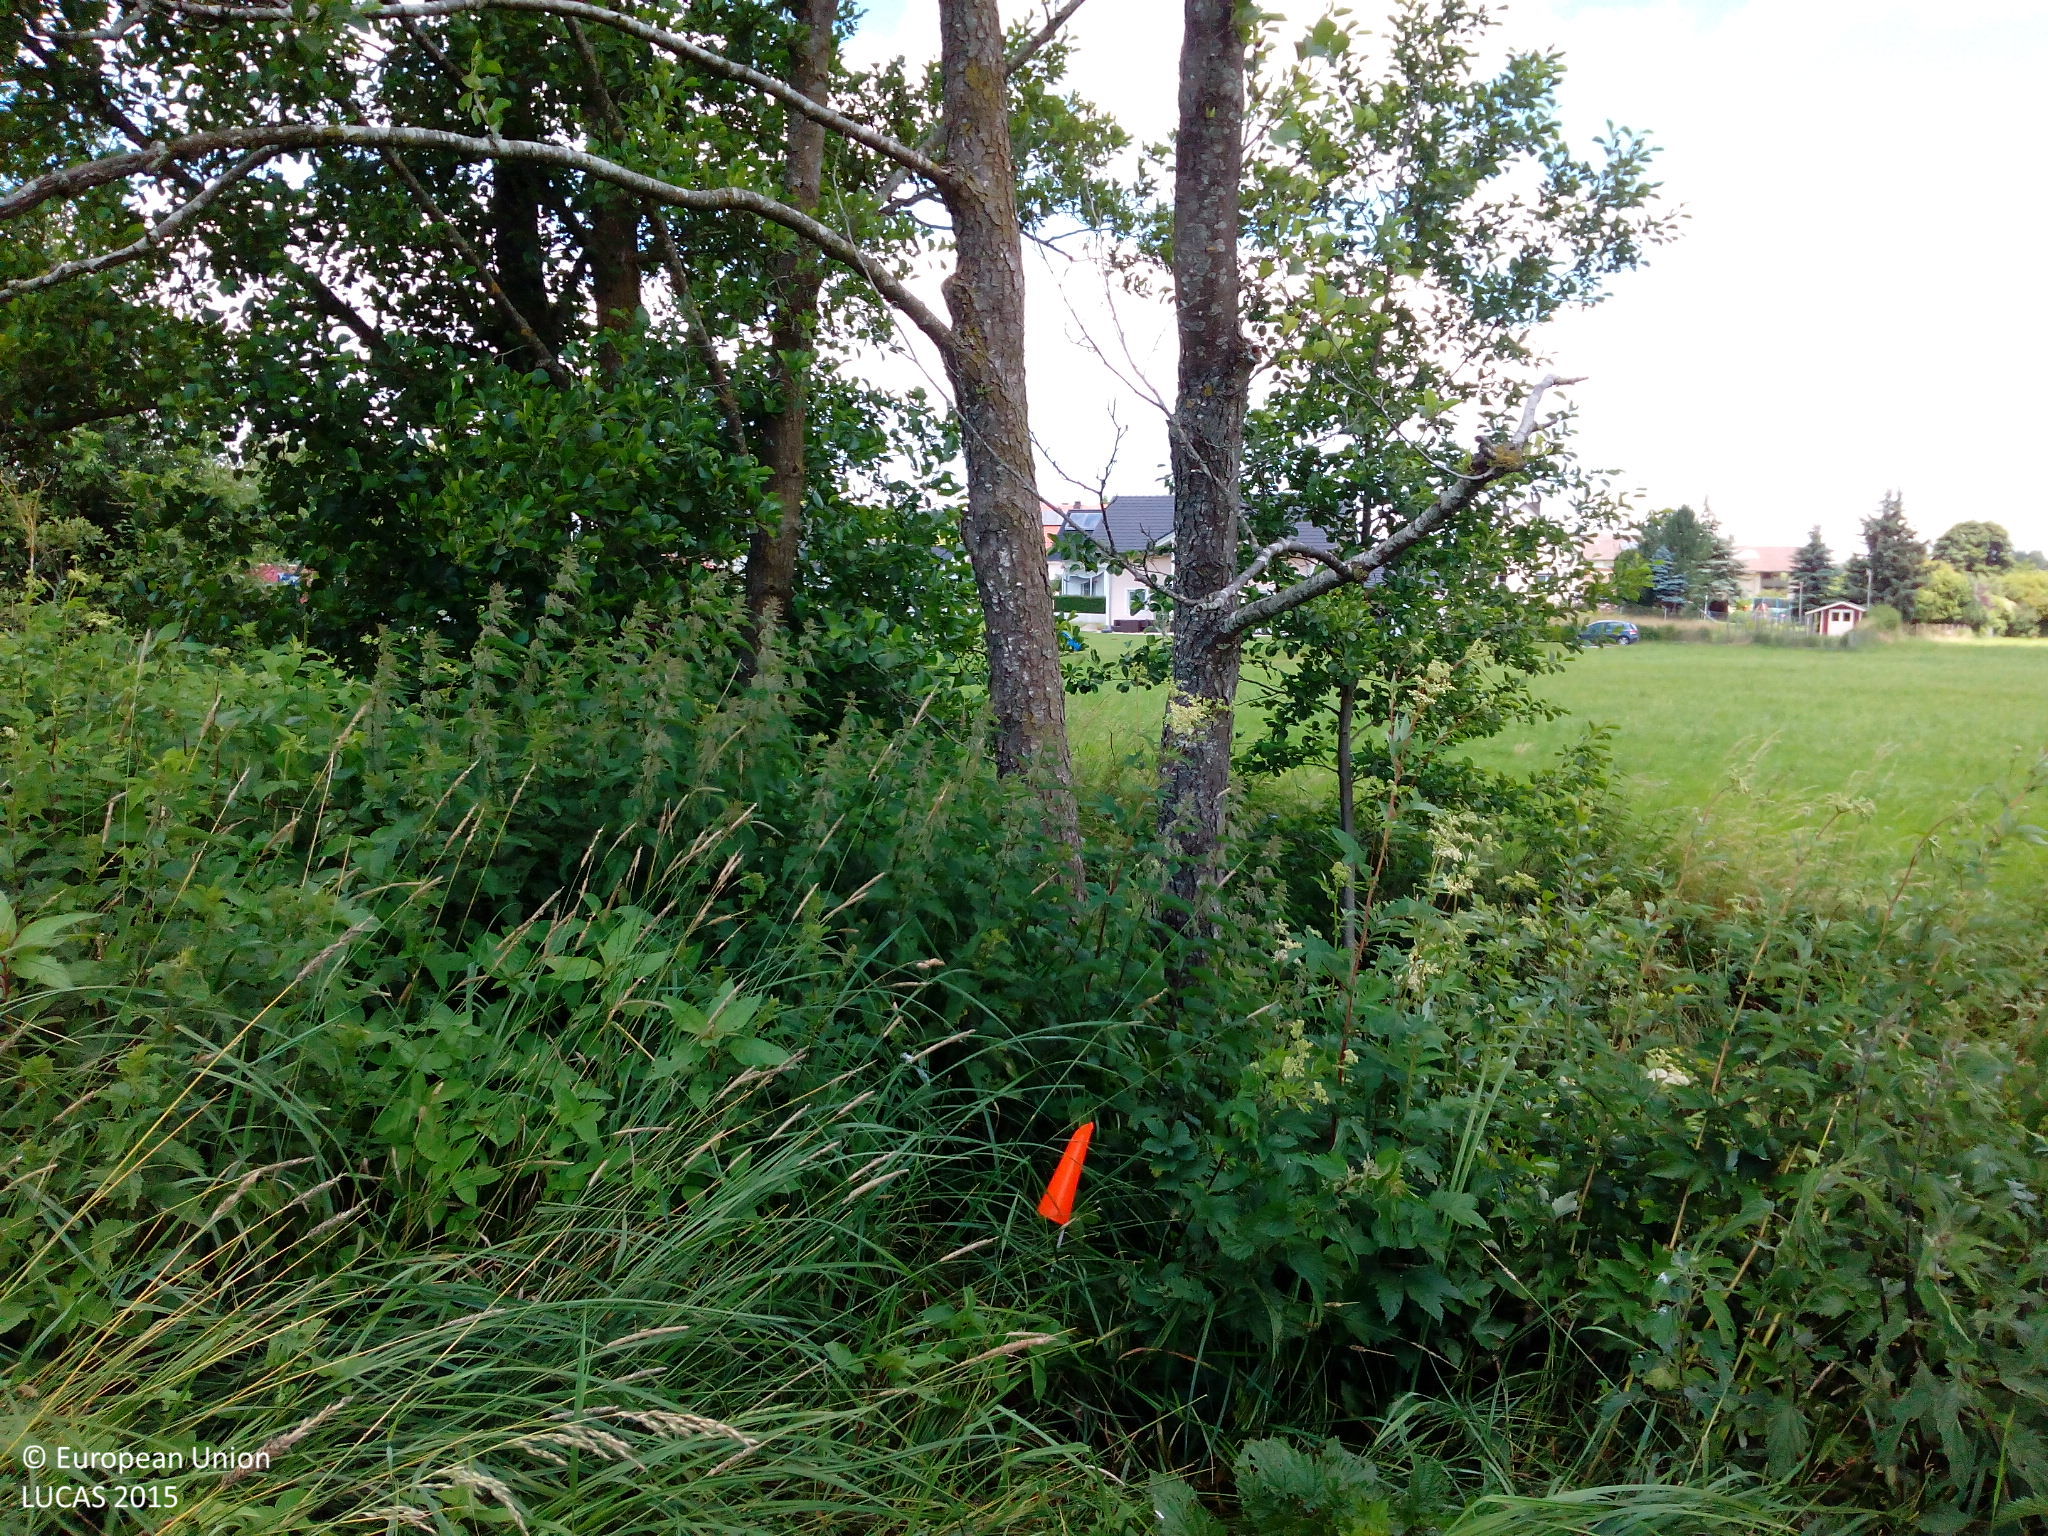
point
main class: Woodland
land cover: Broadleaved woodland
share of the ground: > 75 %
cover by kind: broadleaved forest trees 80 %, shrubs 10 %, herbaceous plants 10 %
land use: Semi-natural and natural areas not in use
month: June
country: DE
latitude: 48.2698
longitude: 12.3837
